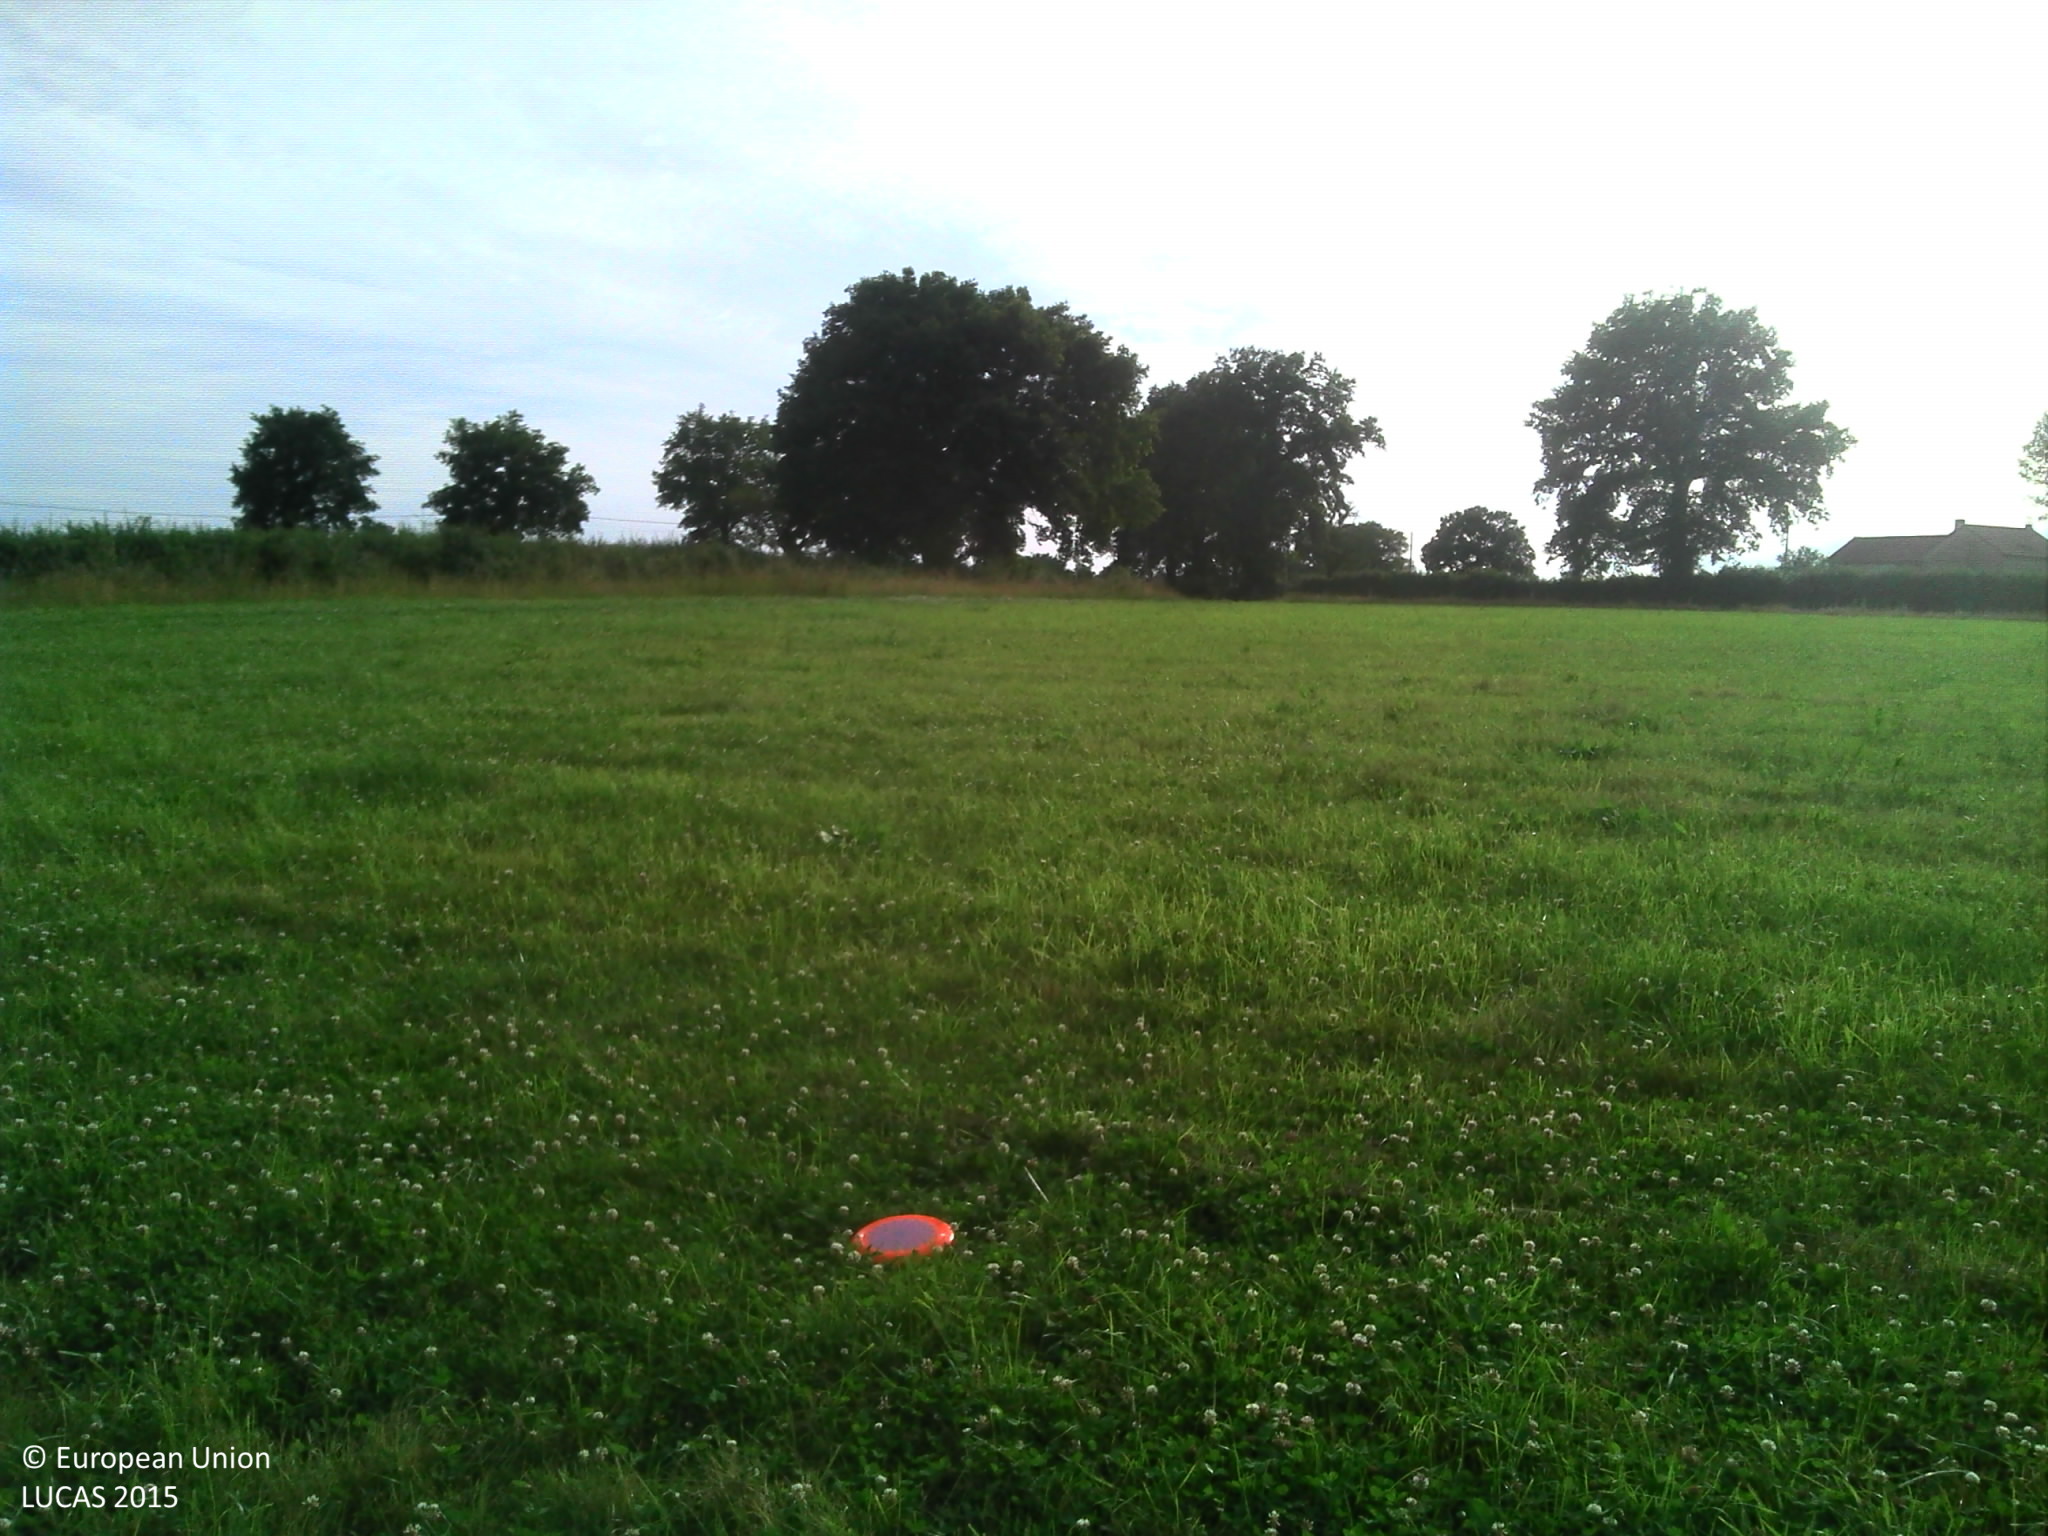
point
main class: Cropland
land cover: Temporary grasslands
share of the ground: > 75 %
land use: Agriculture (excluding fallow land and kitchen gardens)
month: June
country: FR
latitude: 46.4744
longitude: 4.0484
